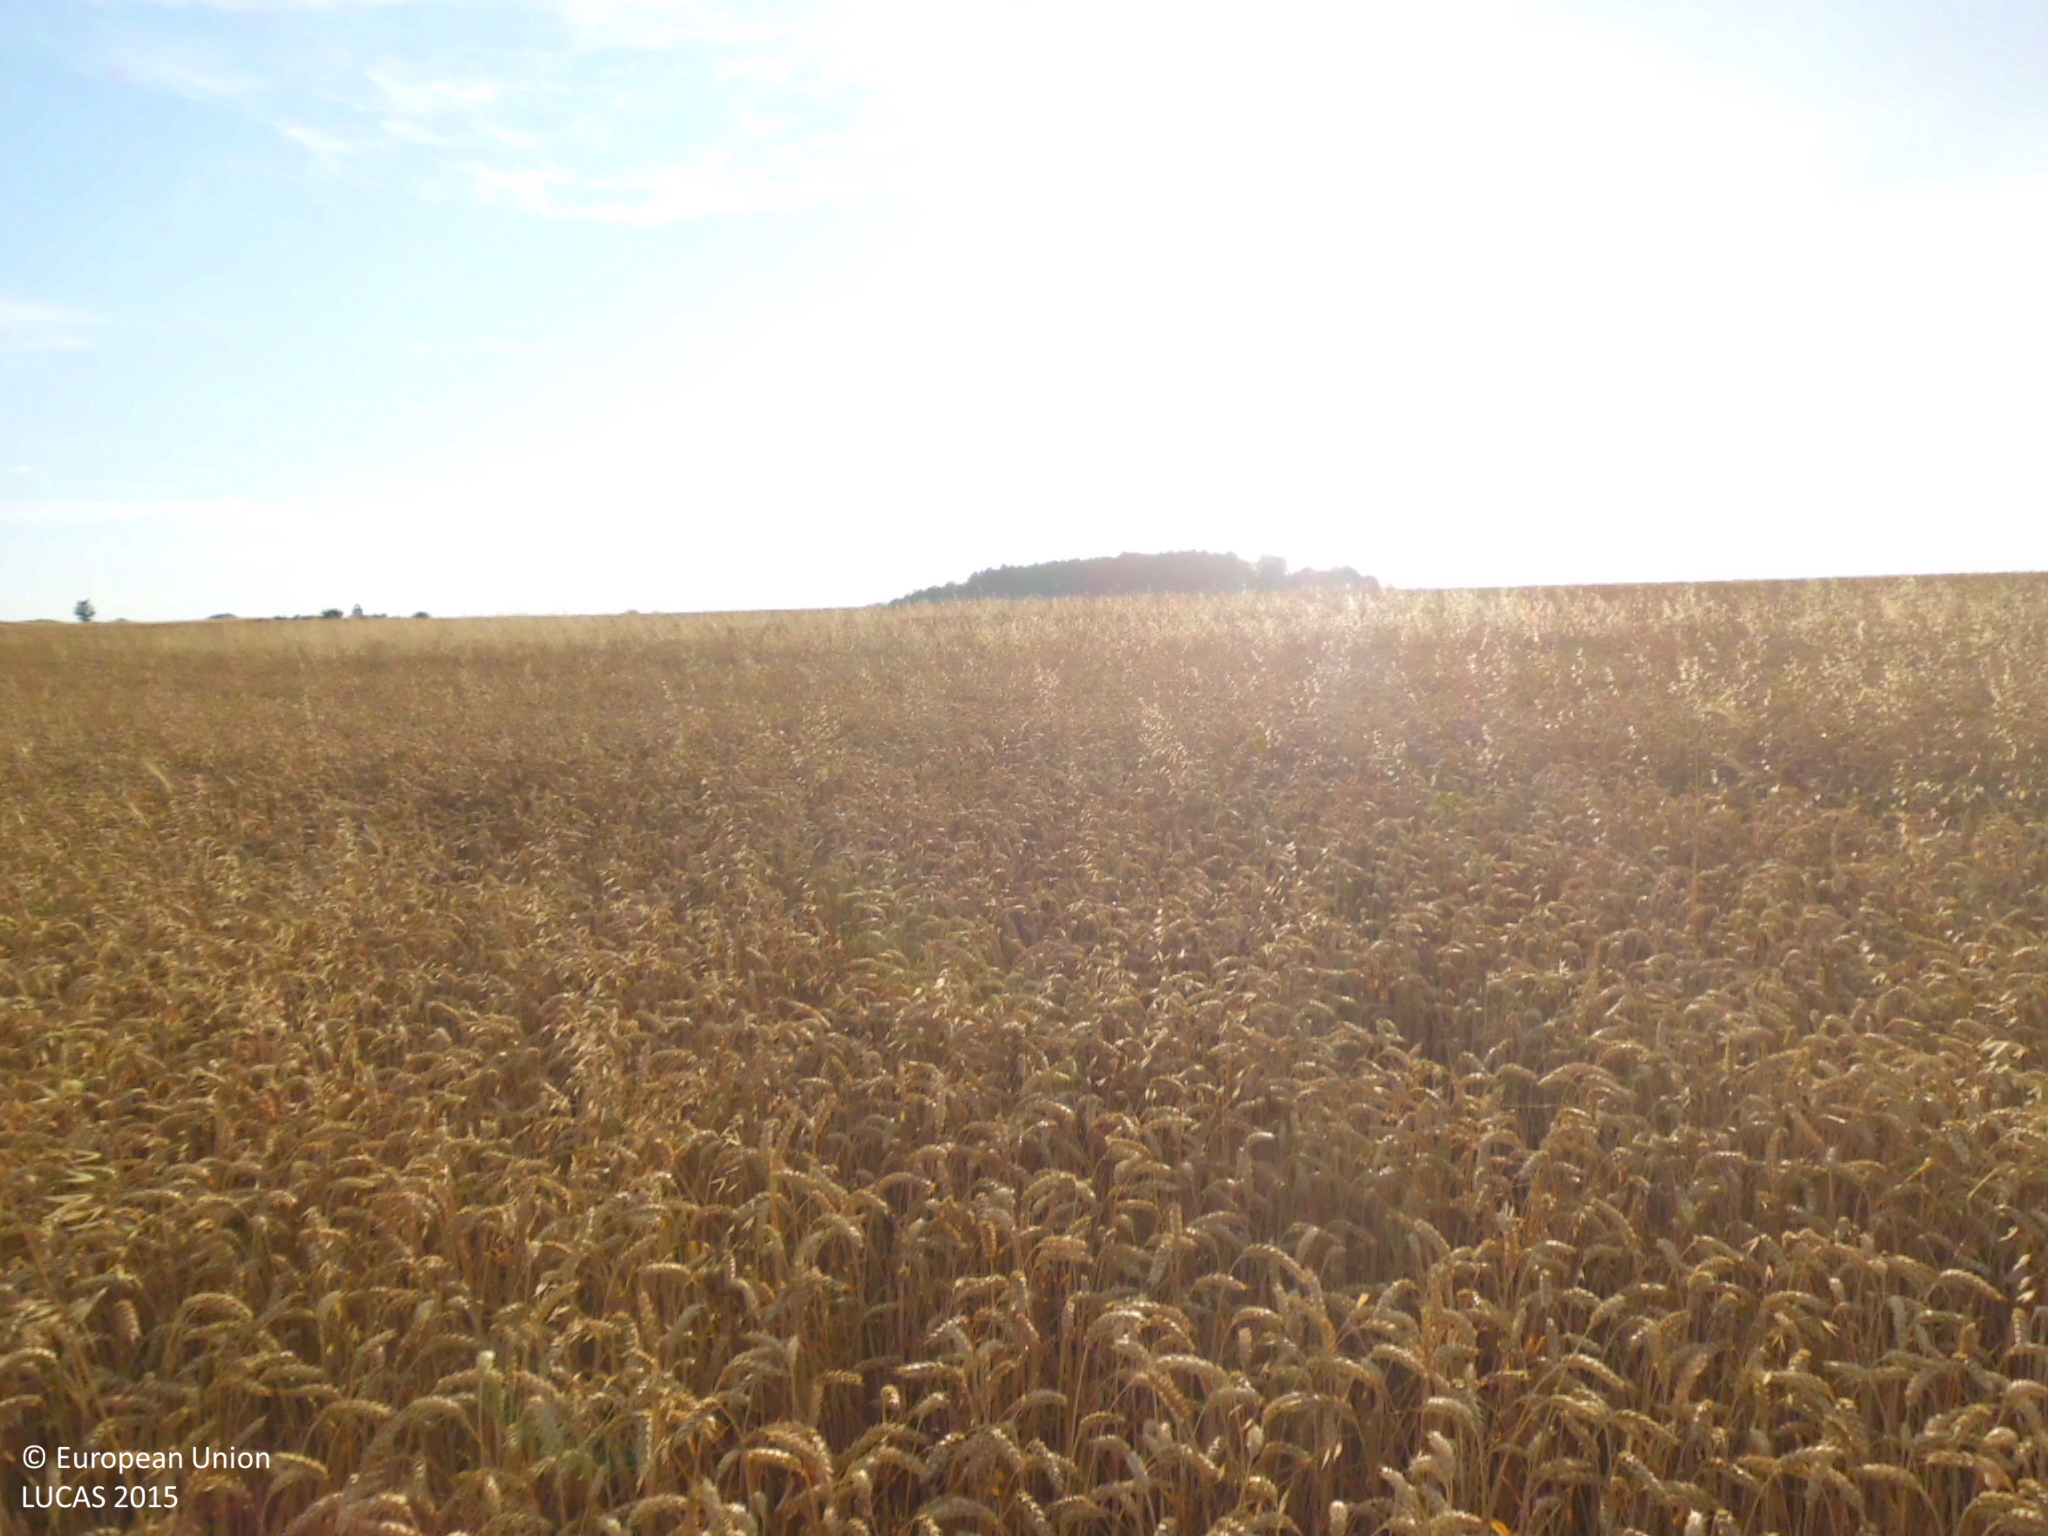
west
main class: Cropland
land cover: Common wheat
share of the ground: > 75 %
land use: Agriculture (excluding fallow land and kitchen gardens)
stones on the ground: 10 - 25 %
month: July
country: ES
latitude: 42.6755
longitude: -4.4389
